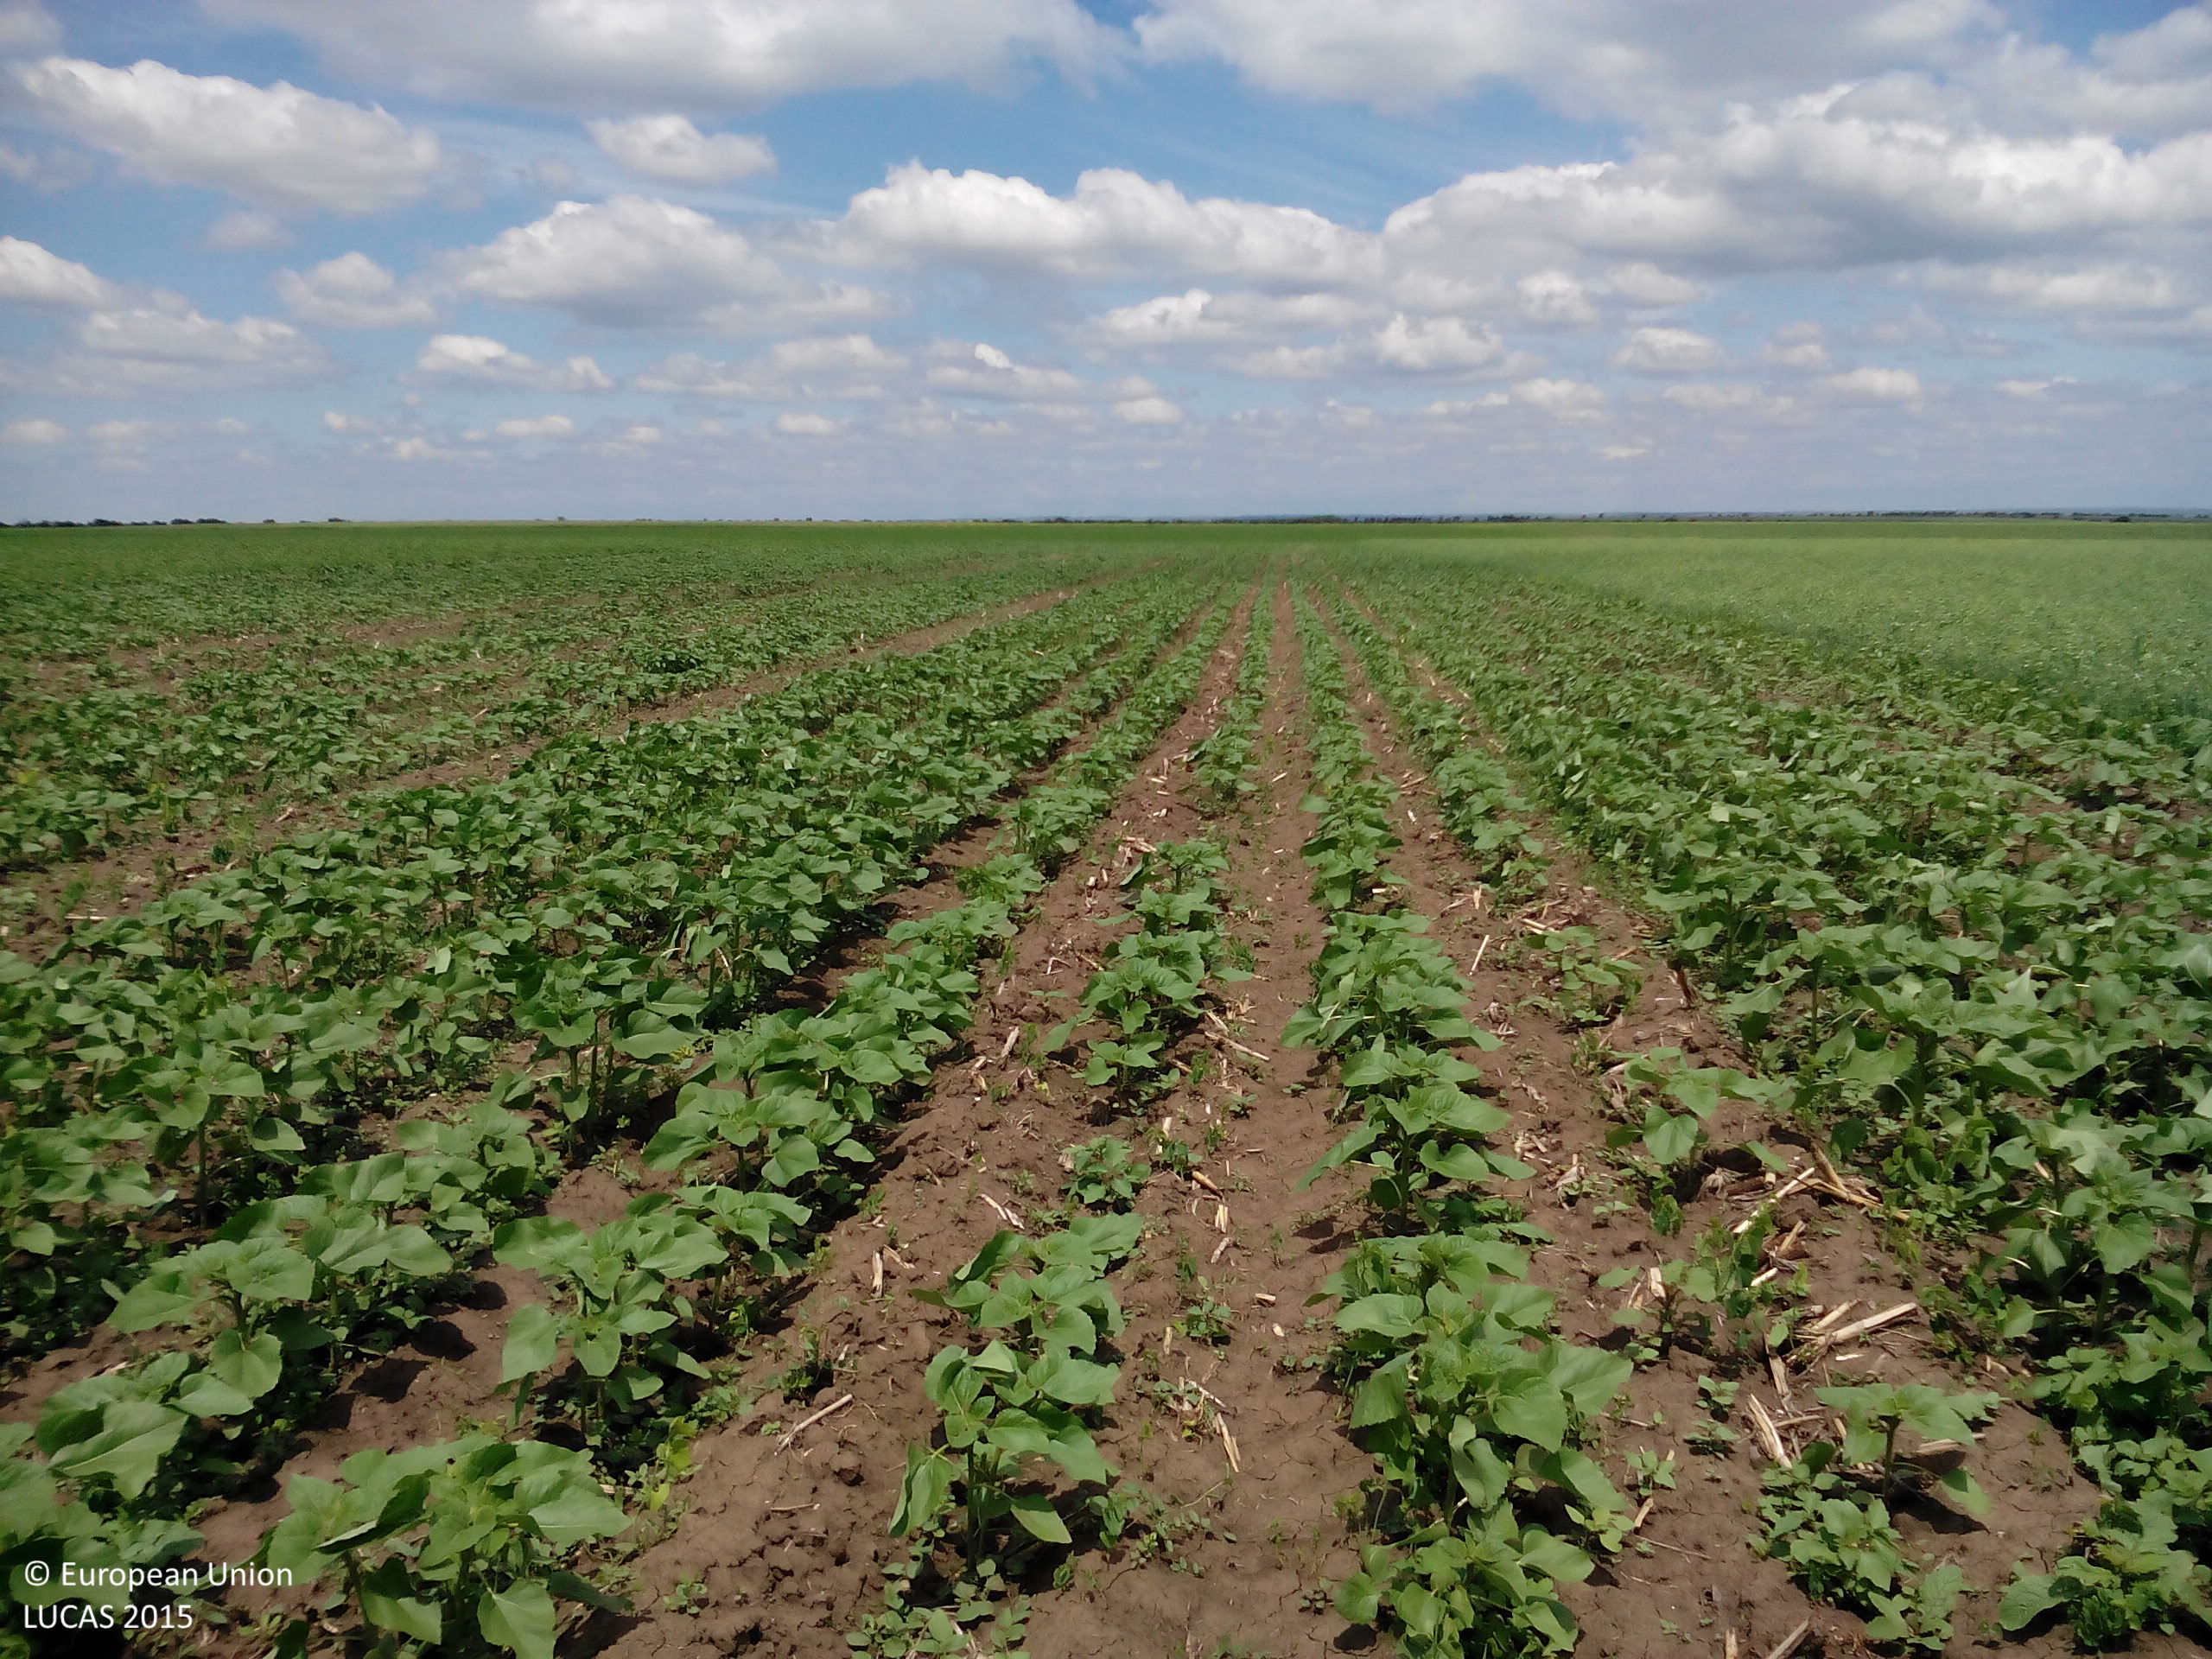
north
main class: Cropland
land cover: Sunflower
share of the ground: 50 - 75 %
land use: Agriculture (excluding fallow land and kitchen gardens)
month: May
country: BG
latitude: 43.5043
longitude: 24.1428
